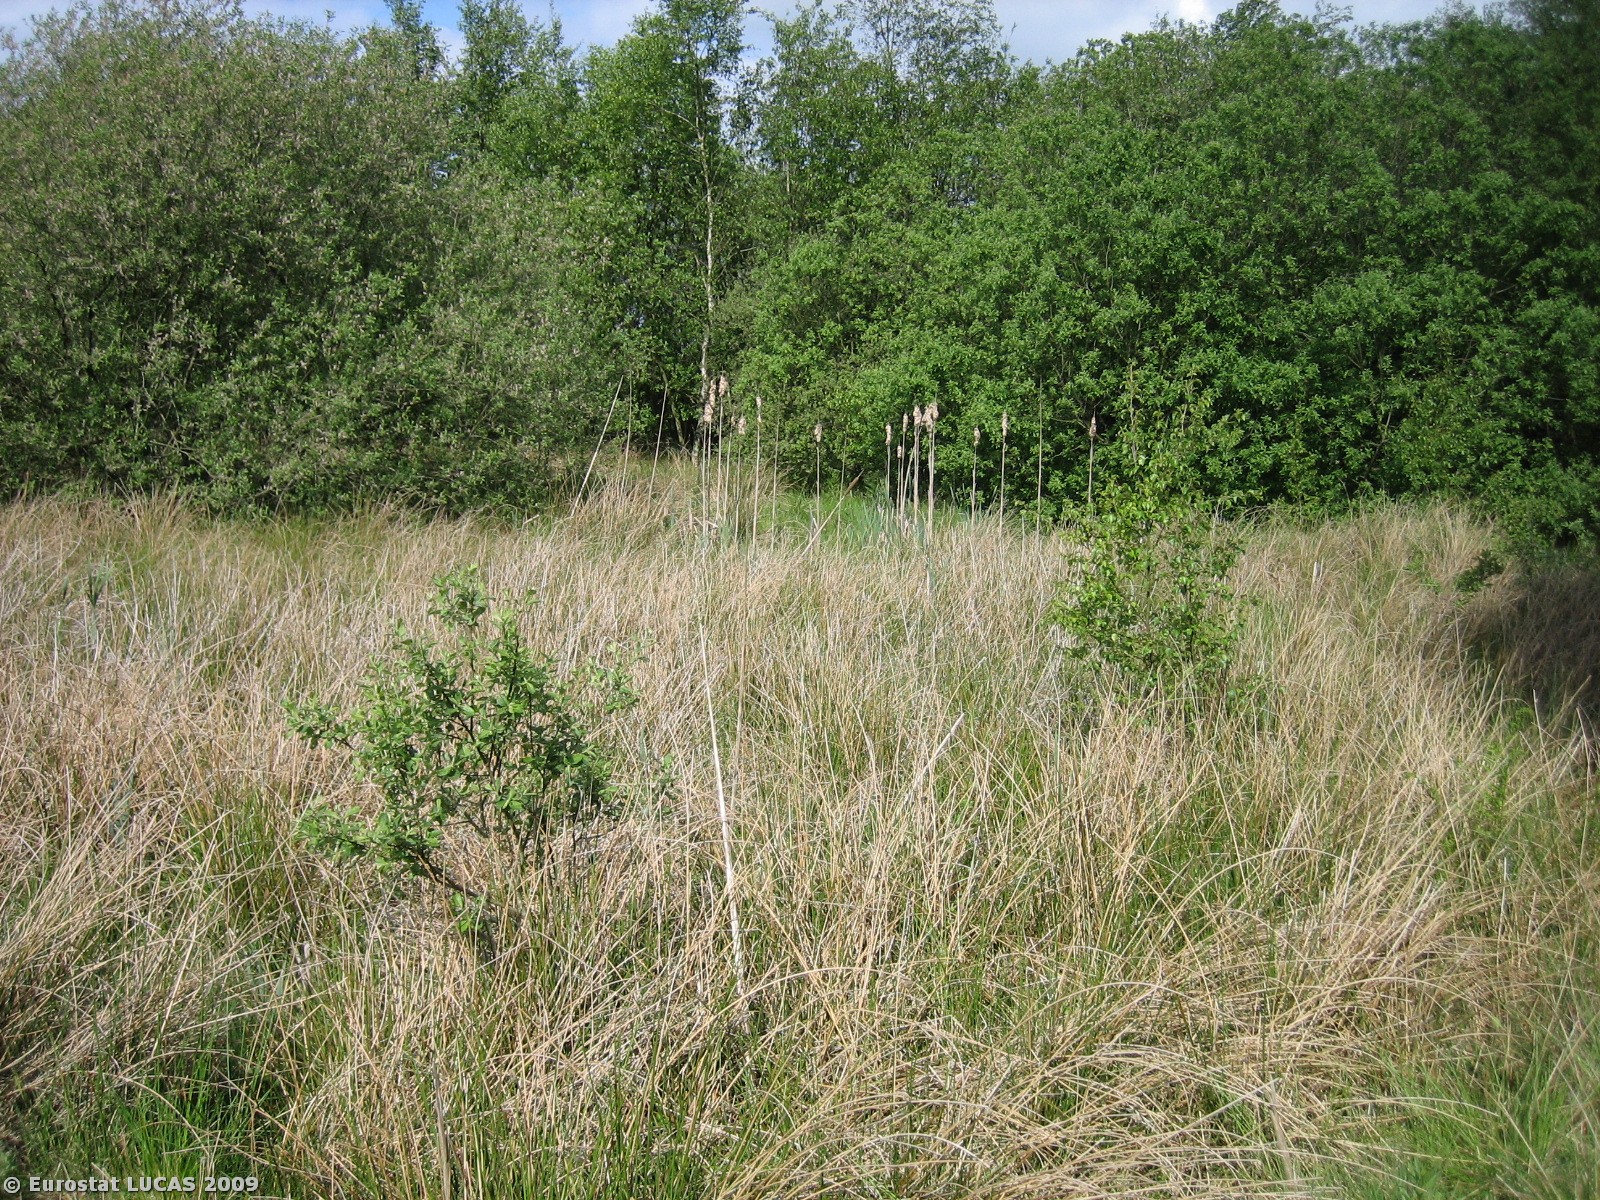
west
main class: Shrubland
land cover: Shrubland with sparse tree cover
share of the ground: > 75 %
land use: Unused
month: May
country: DK
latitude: 56.0928
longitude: 8.8601
